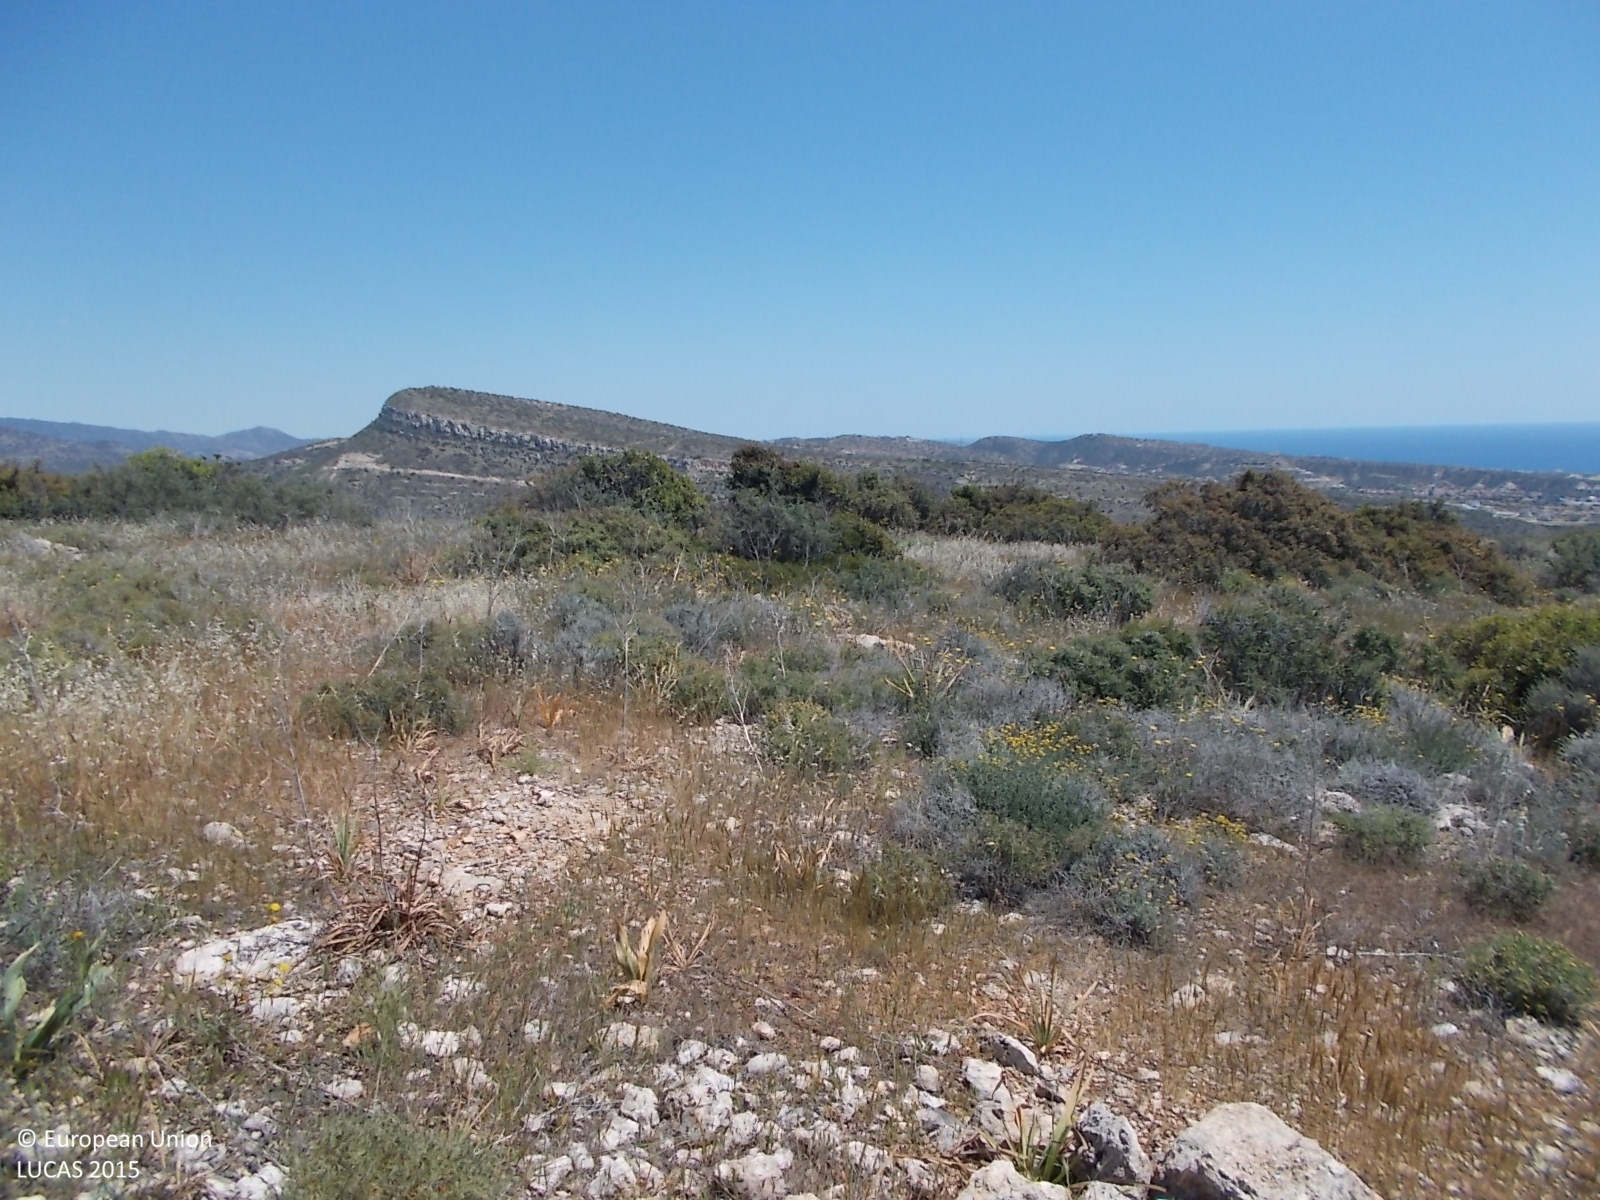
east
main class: Shrubland
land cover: Shrubland with sparse tree cover
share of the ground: 50 - 75 %
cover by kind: shrubs 65 %, herbaceous plants 15 %, unconsolidated bare surface 10 %, broadleaved forest trees 5 %, consolidated bare surface 5 %
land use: Semi-natural and natural areas not in use
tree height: < 5 m
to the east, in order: Shrubland with sparse tree cover; Tracks; Shrubland with sparse tree cover
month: April
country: CY
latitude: 34.7382
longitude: 33.0714
